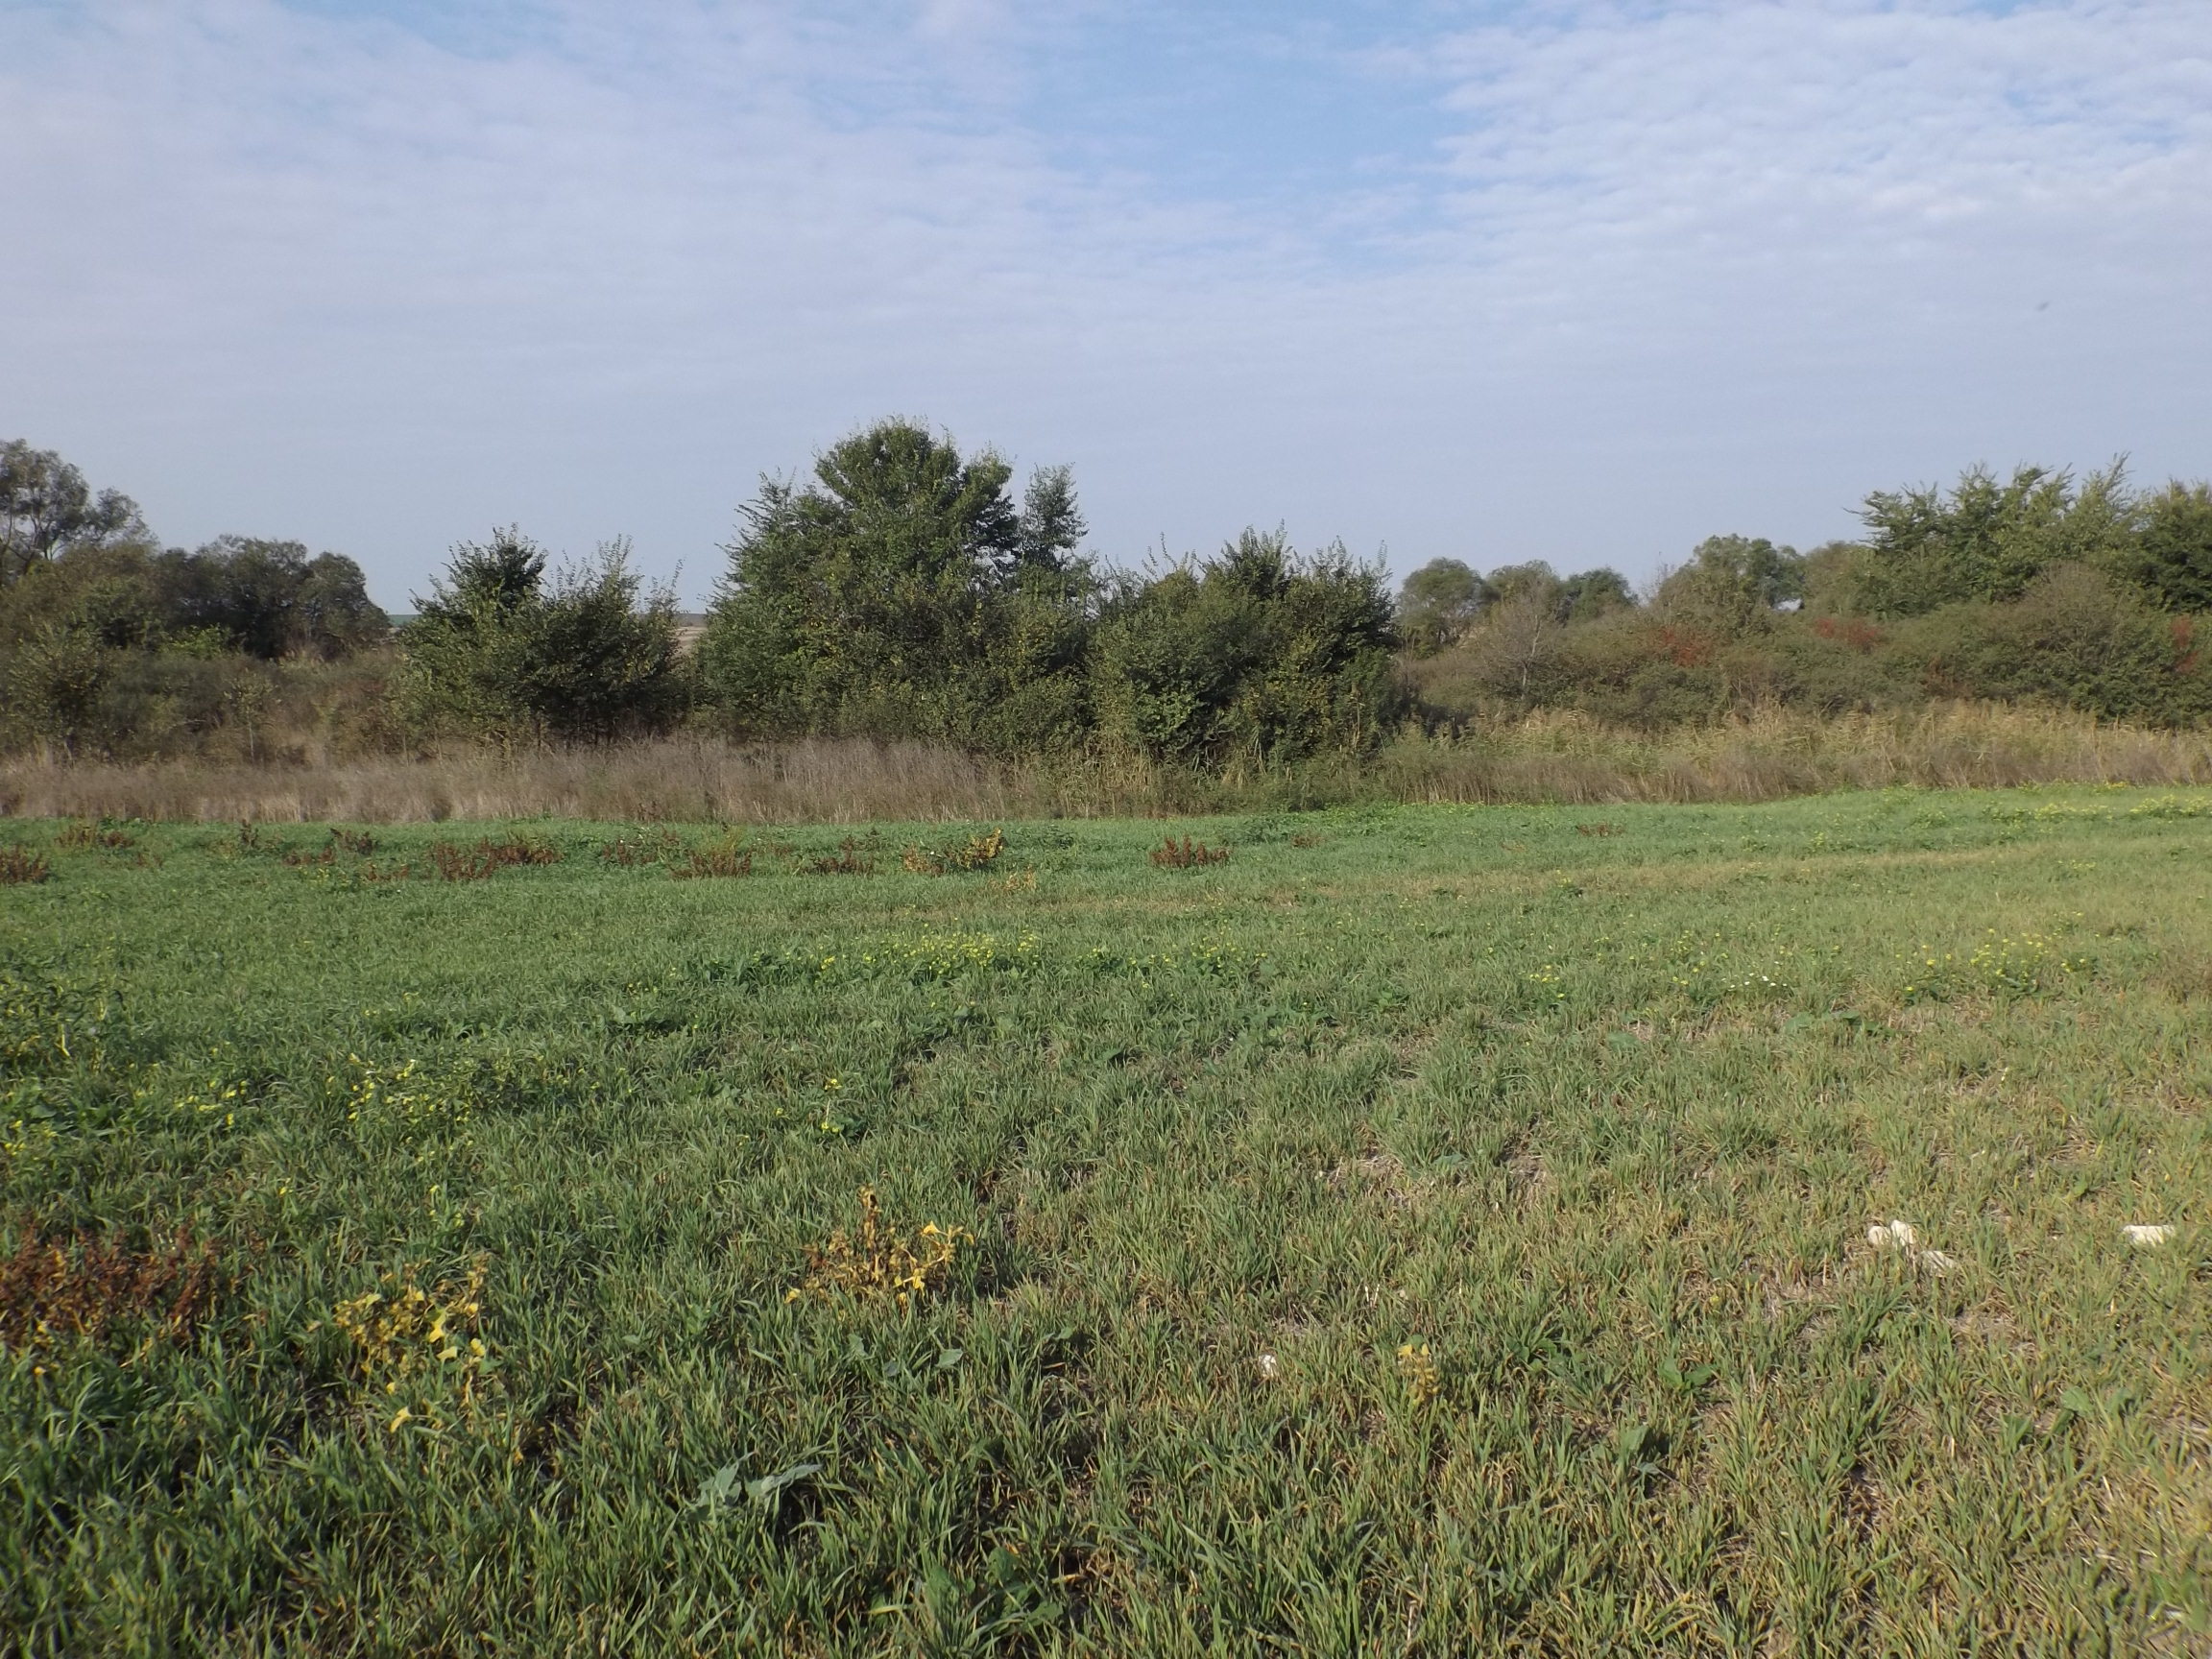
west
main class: Cropland
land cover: Common wheat
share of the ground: < 10 %
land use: Agriculture (excluding fallow land and kitchen gardens)
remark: Harvested field
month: October
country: BG
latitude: 43.1573
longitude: 27.5294
